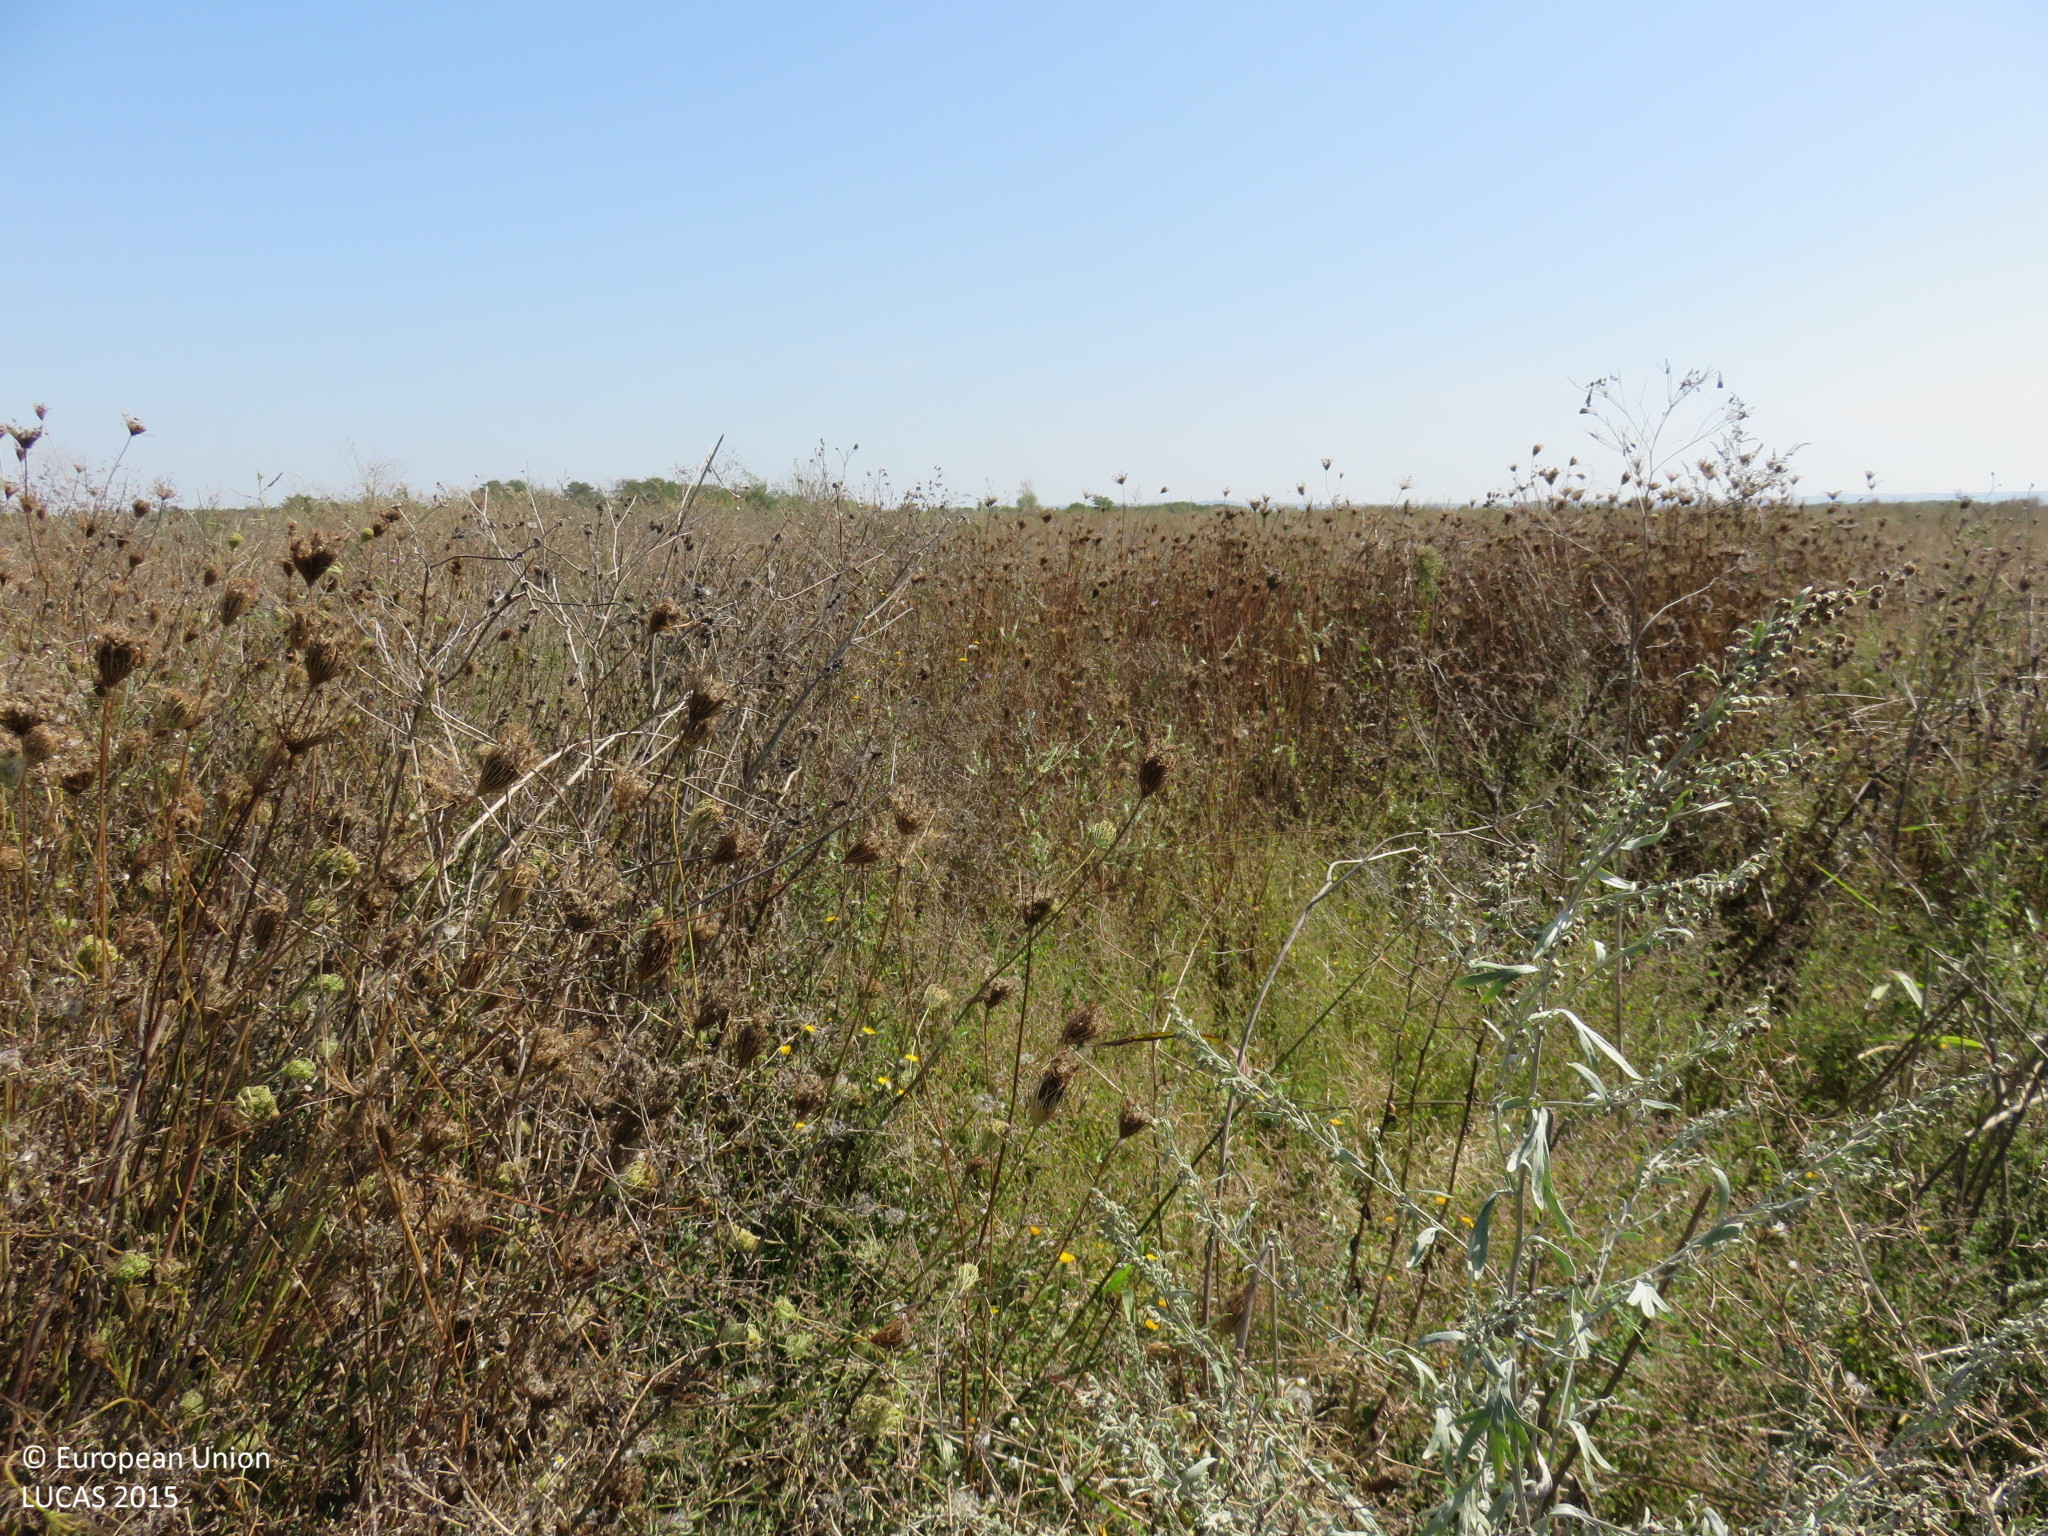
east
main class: Grassland
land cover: Spontaneously vegetated surfaces
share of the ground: > 75 %
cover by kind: herbaceous plants 100 %
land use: Agriculture (excluding fallow land and kitchen gardens)
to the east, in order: Spontaneously vegetated surfaces; Grassland with sparse tree/shrub cover; Ditches and canals; Grassland with sparse tree/shrub cover; Sunflower; Grass margins; Tracks; Grass margins
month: September
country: BG
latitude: 43.7107
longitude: 24.6238
